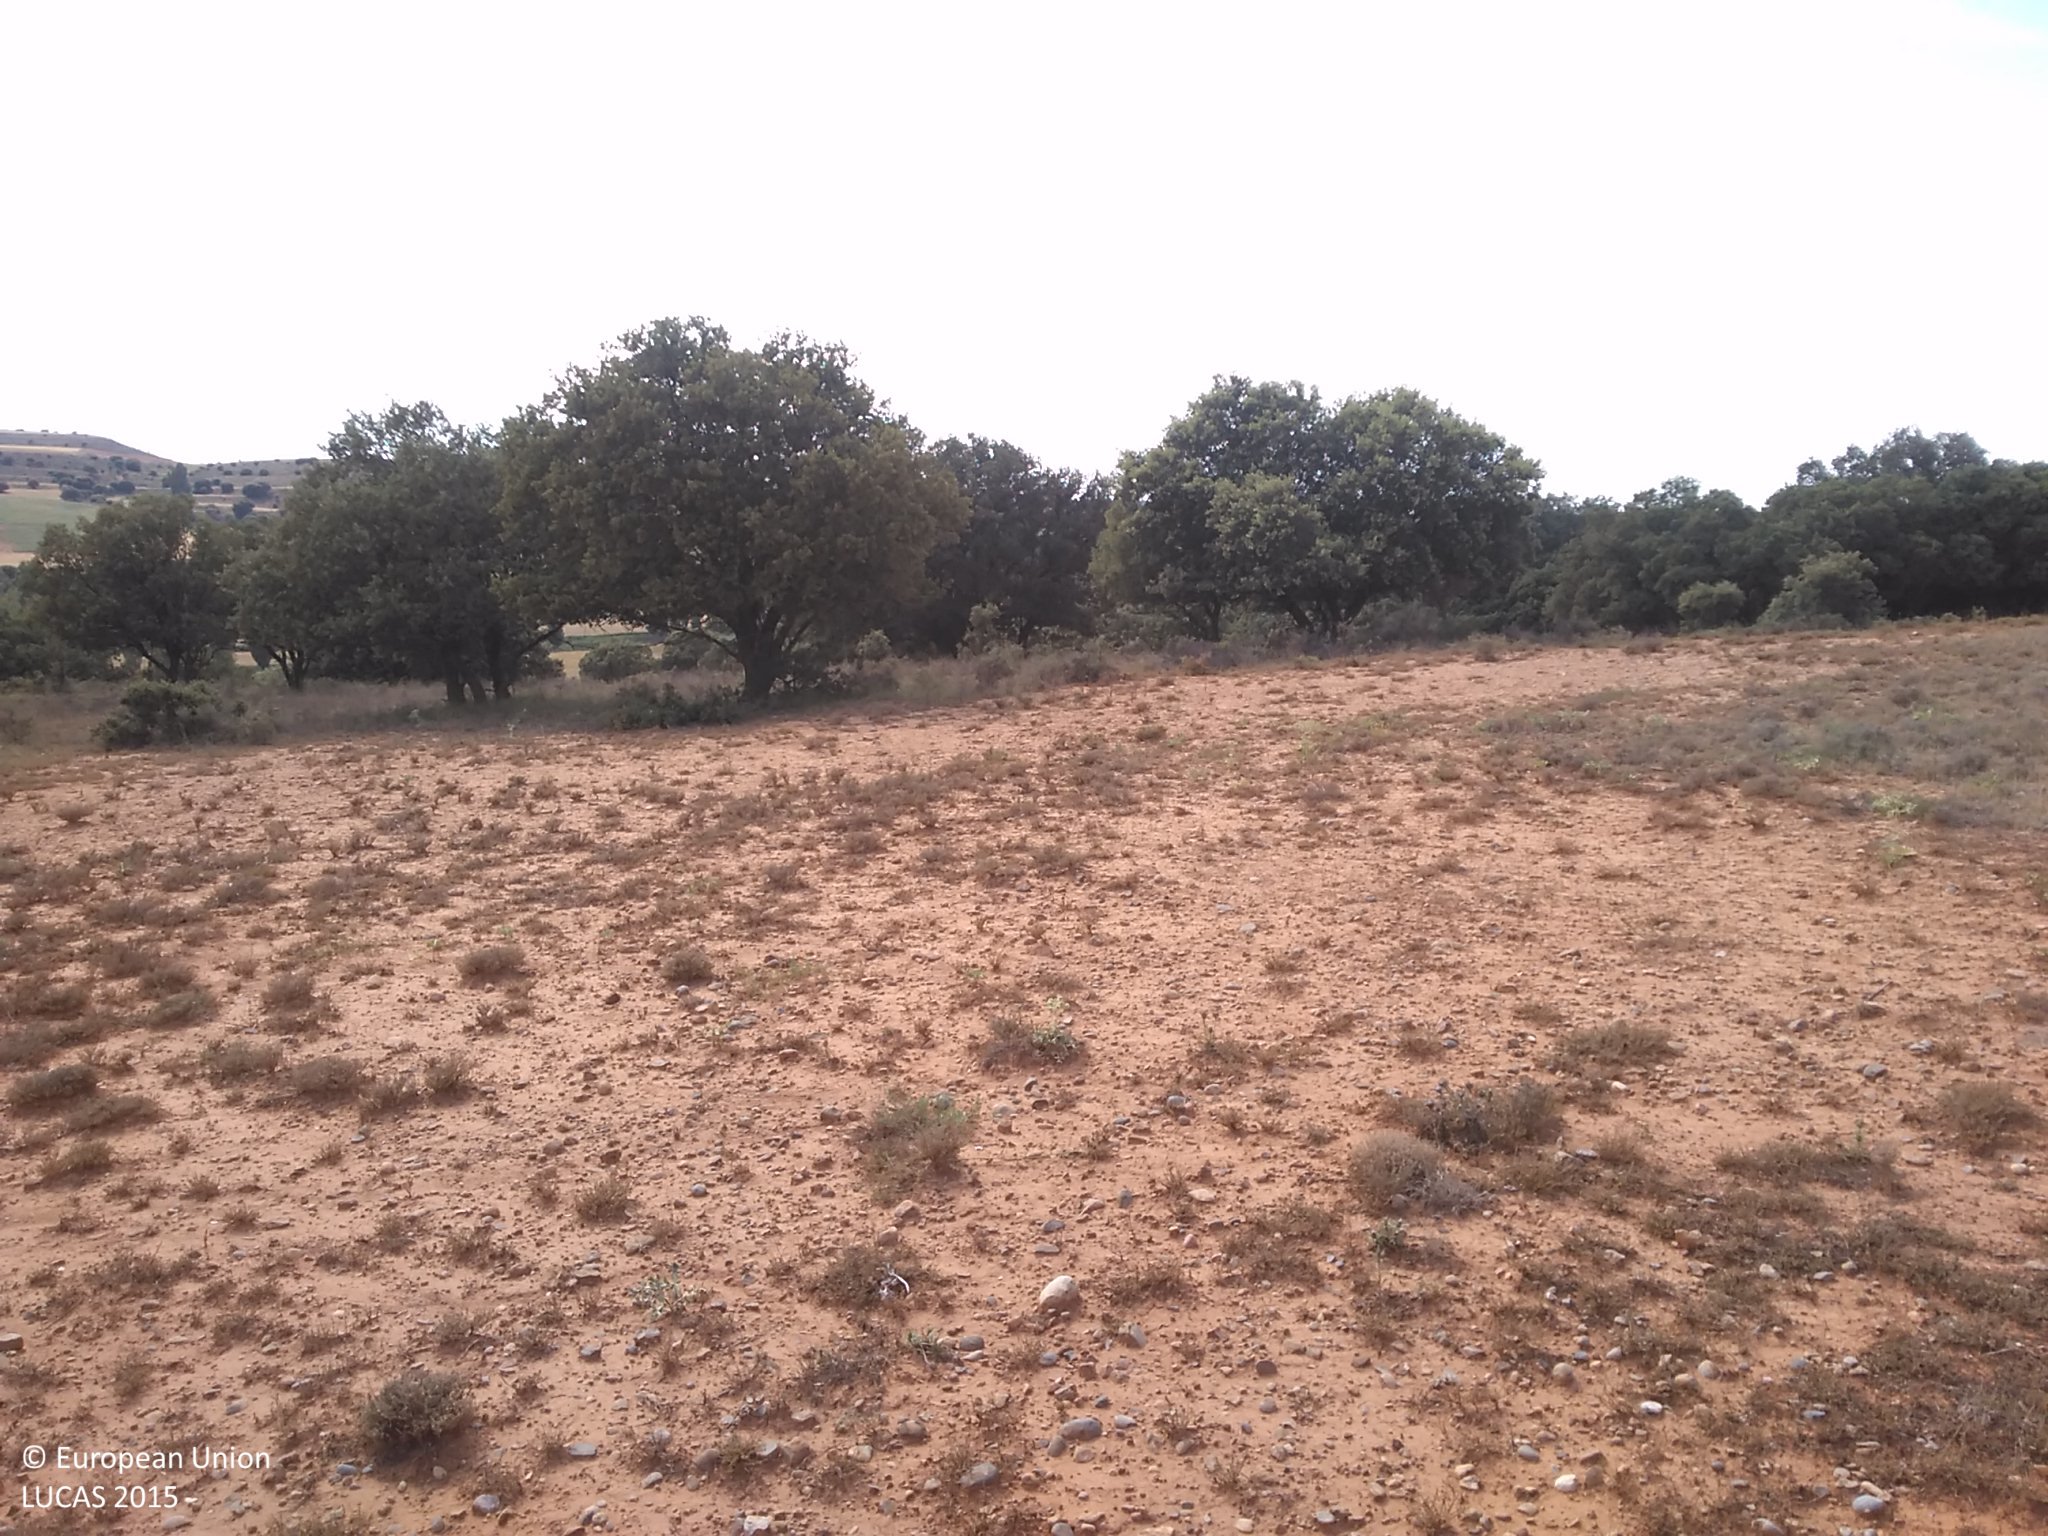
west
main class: Grassland
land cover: Spontaneously vegetated surfaces
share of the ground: 25 - 50 %
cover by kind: unconsolidated bare surface 50 %, herbaceous plants 45 %, shrubs 5 %
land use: Semi-natural and natural areas not in use
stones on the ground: < 10 %
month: July
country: ES
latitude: 41.5099
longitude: -2.2175
